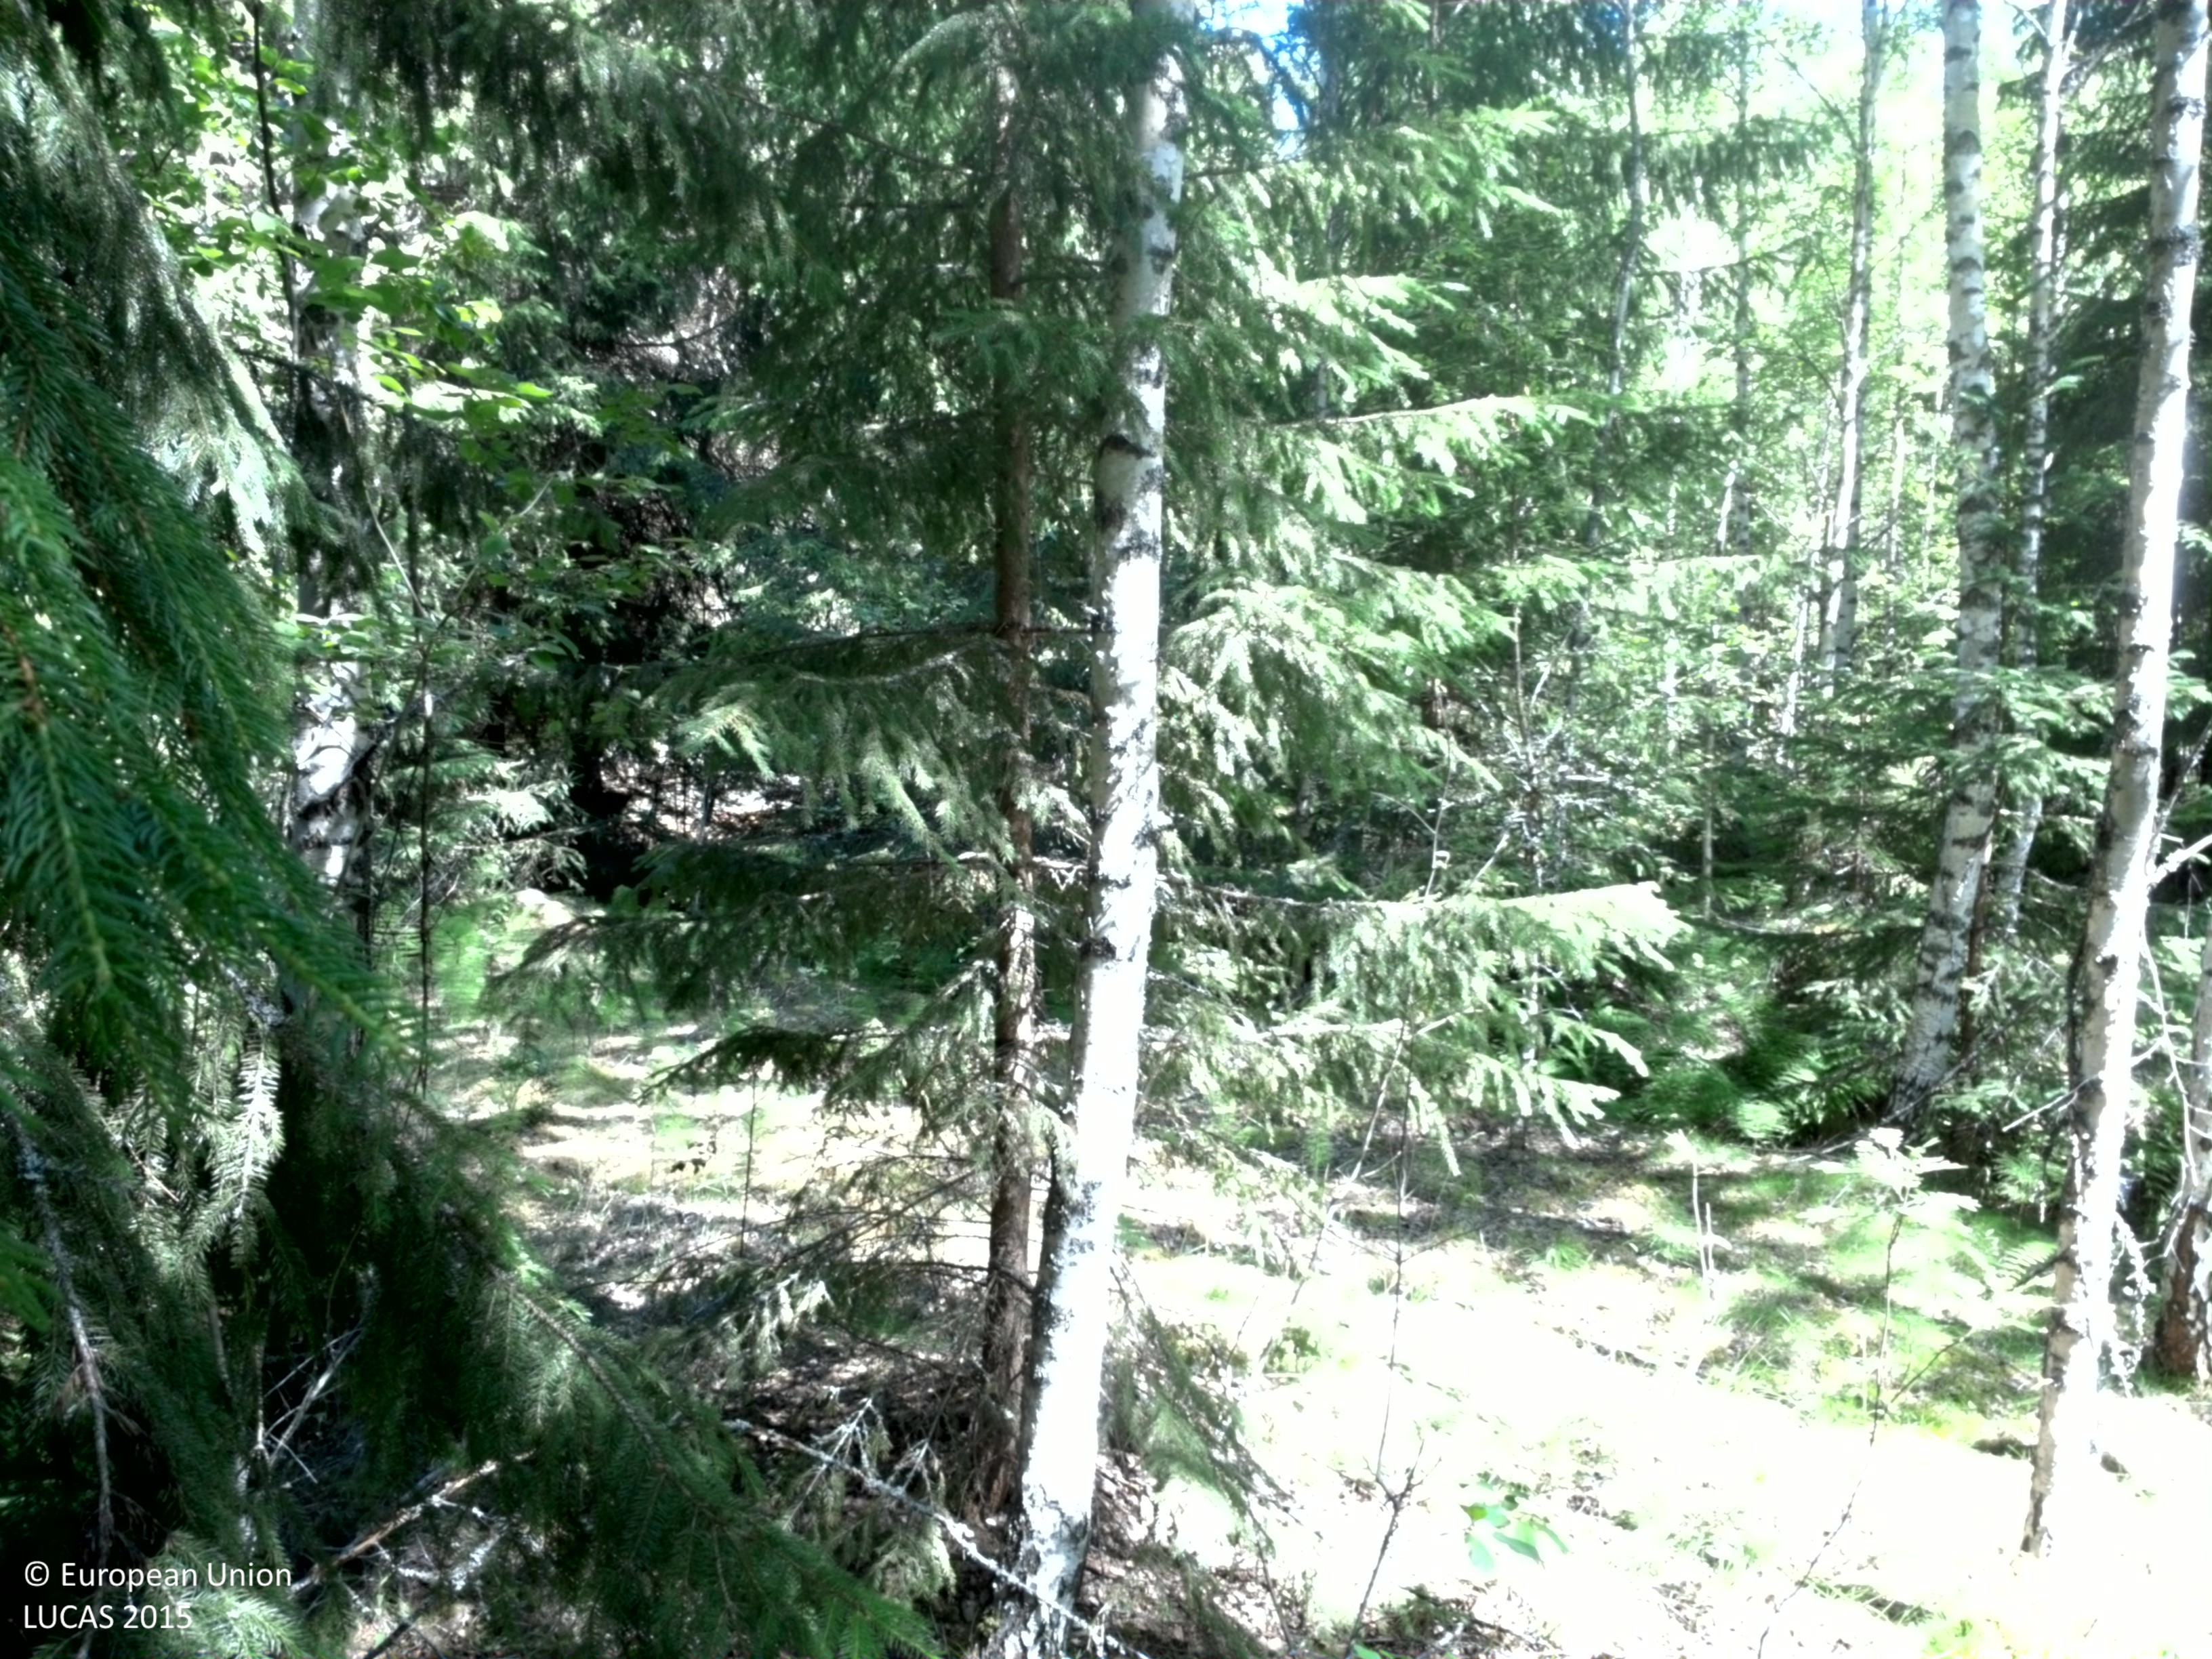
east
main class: Woodland
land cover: Spruce dominated mixed woodland
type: boreal forest
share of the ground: > 75 %
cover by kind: coniferous forest trees 70 %, broadleaved forest trees 25 %, lichens and mosses 5 %
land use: Forestry
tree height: > 5 m
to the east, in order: Spruce dominated mixed woodland; Spruce dominated coniferous woodland; Other coniferous woodland; Pine dominated coniferous woodland; Grassland with sparse tree/shrub cover; Broadleaved woodland
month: July
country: SE
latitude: 59.9847
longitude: 16.7118
